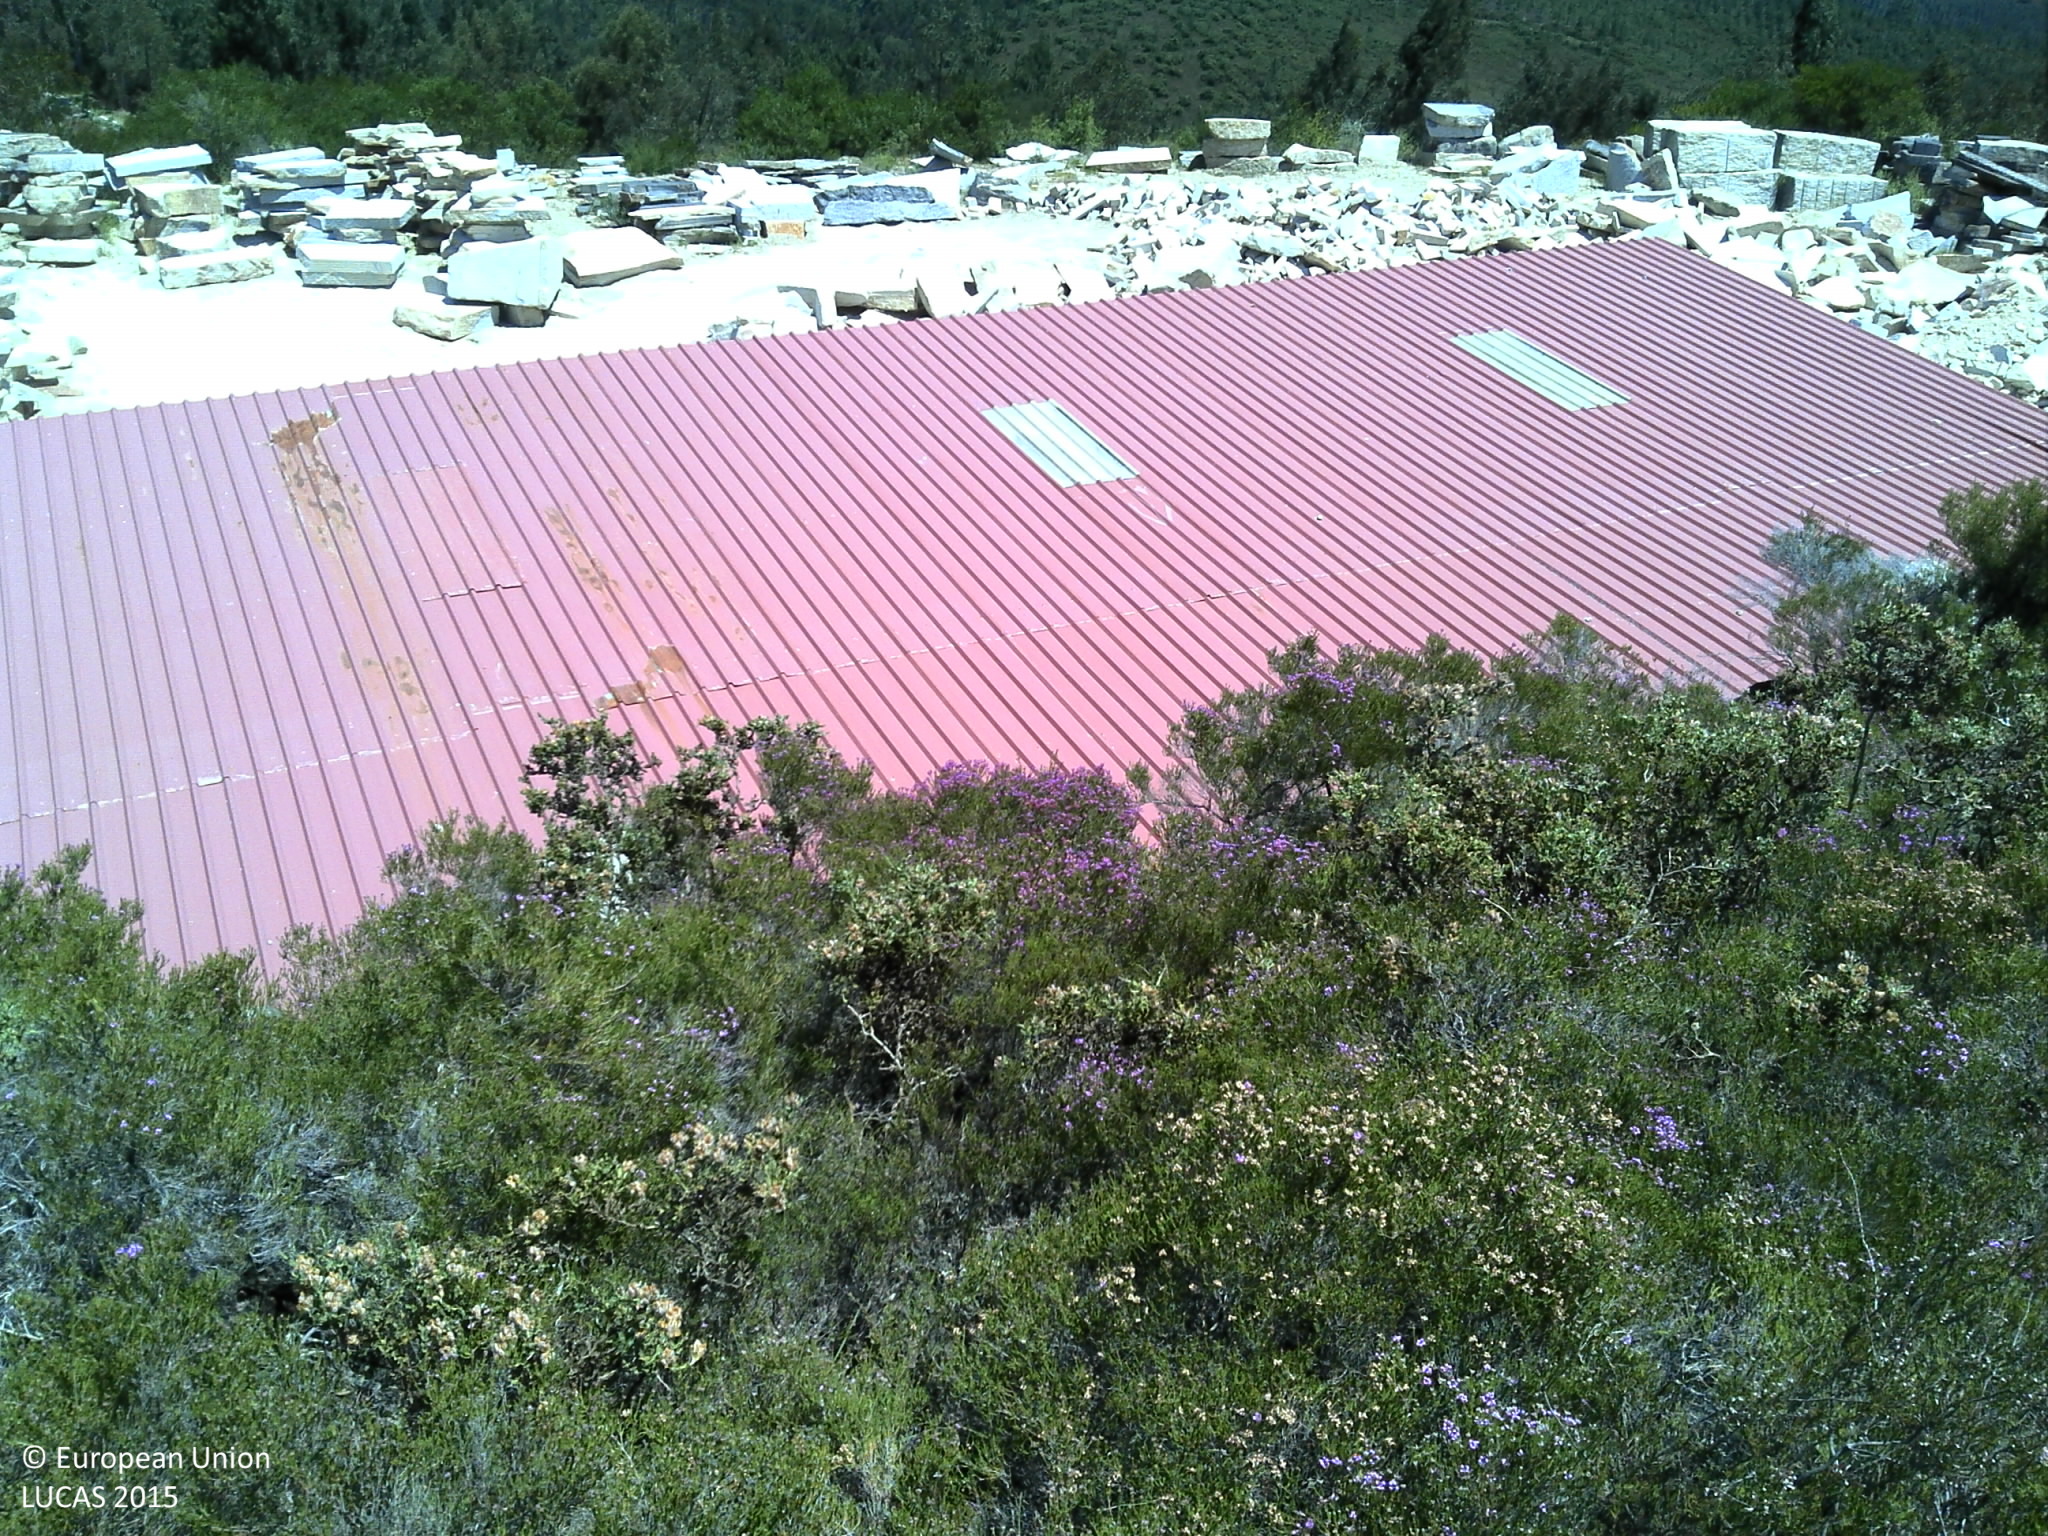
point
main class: Shrubland
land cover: Shrubland without tree cover
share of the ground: 50 - 75 %
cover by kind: shrubs 75 %, unconsolidated bare surface 20 %, herbaceous plants 5 %
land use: Semi-natural and natural areas not in use
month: May
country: PT
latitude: 41.8154
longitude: -8.6184
